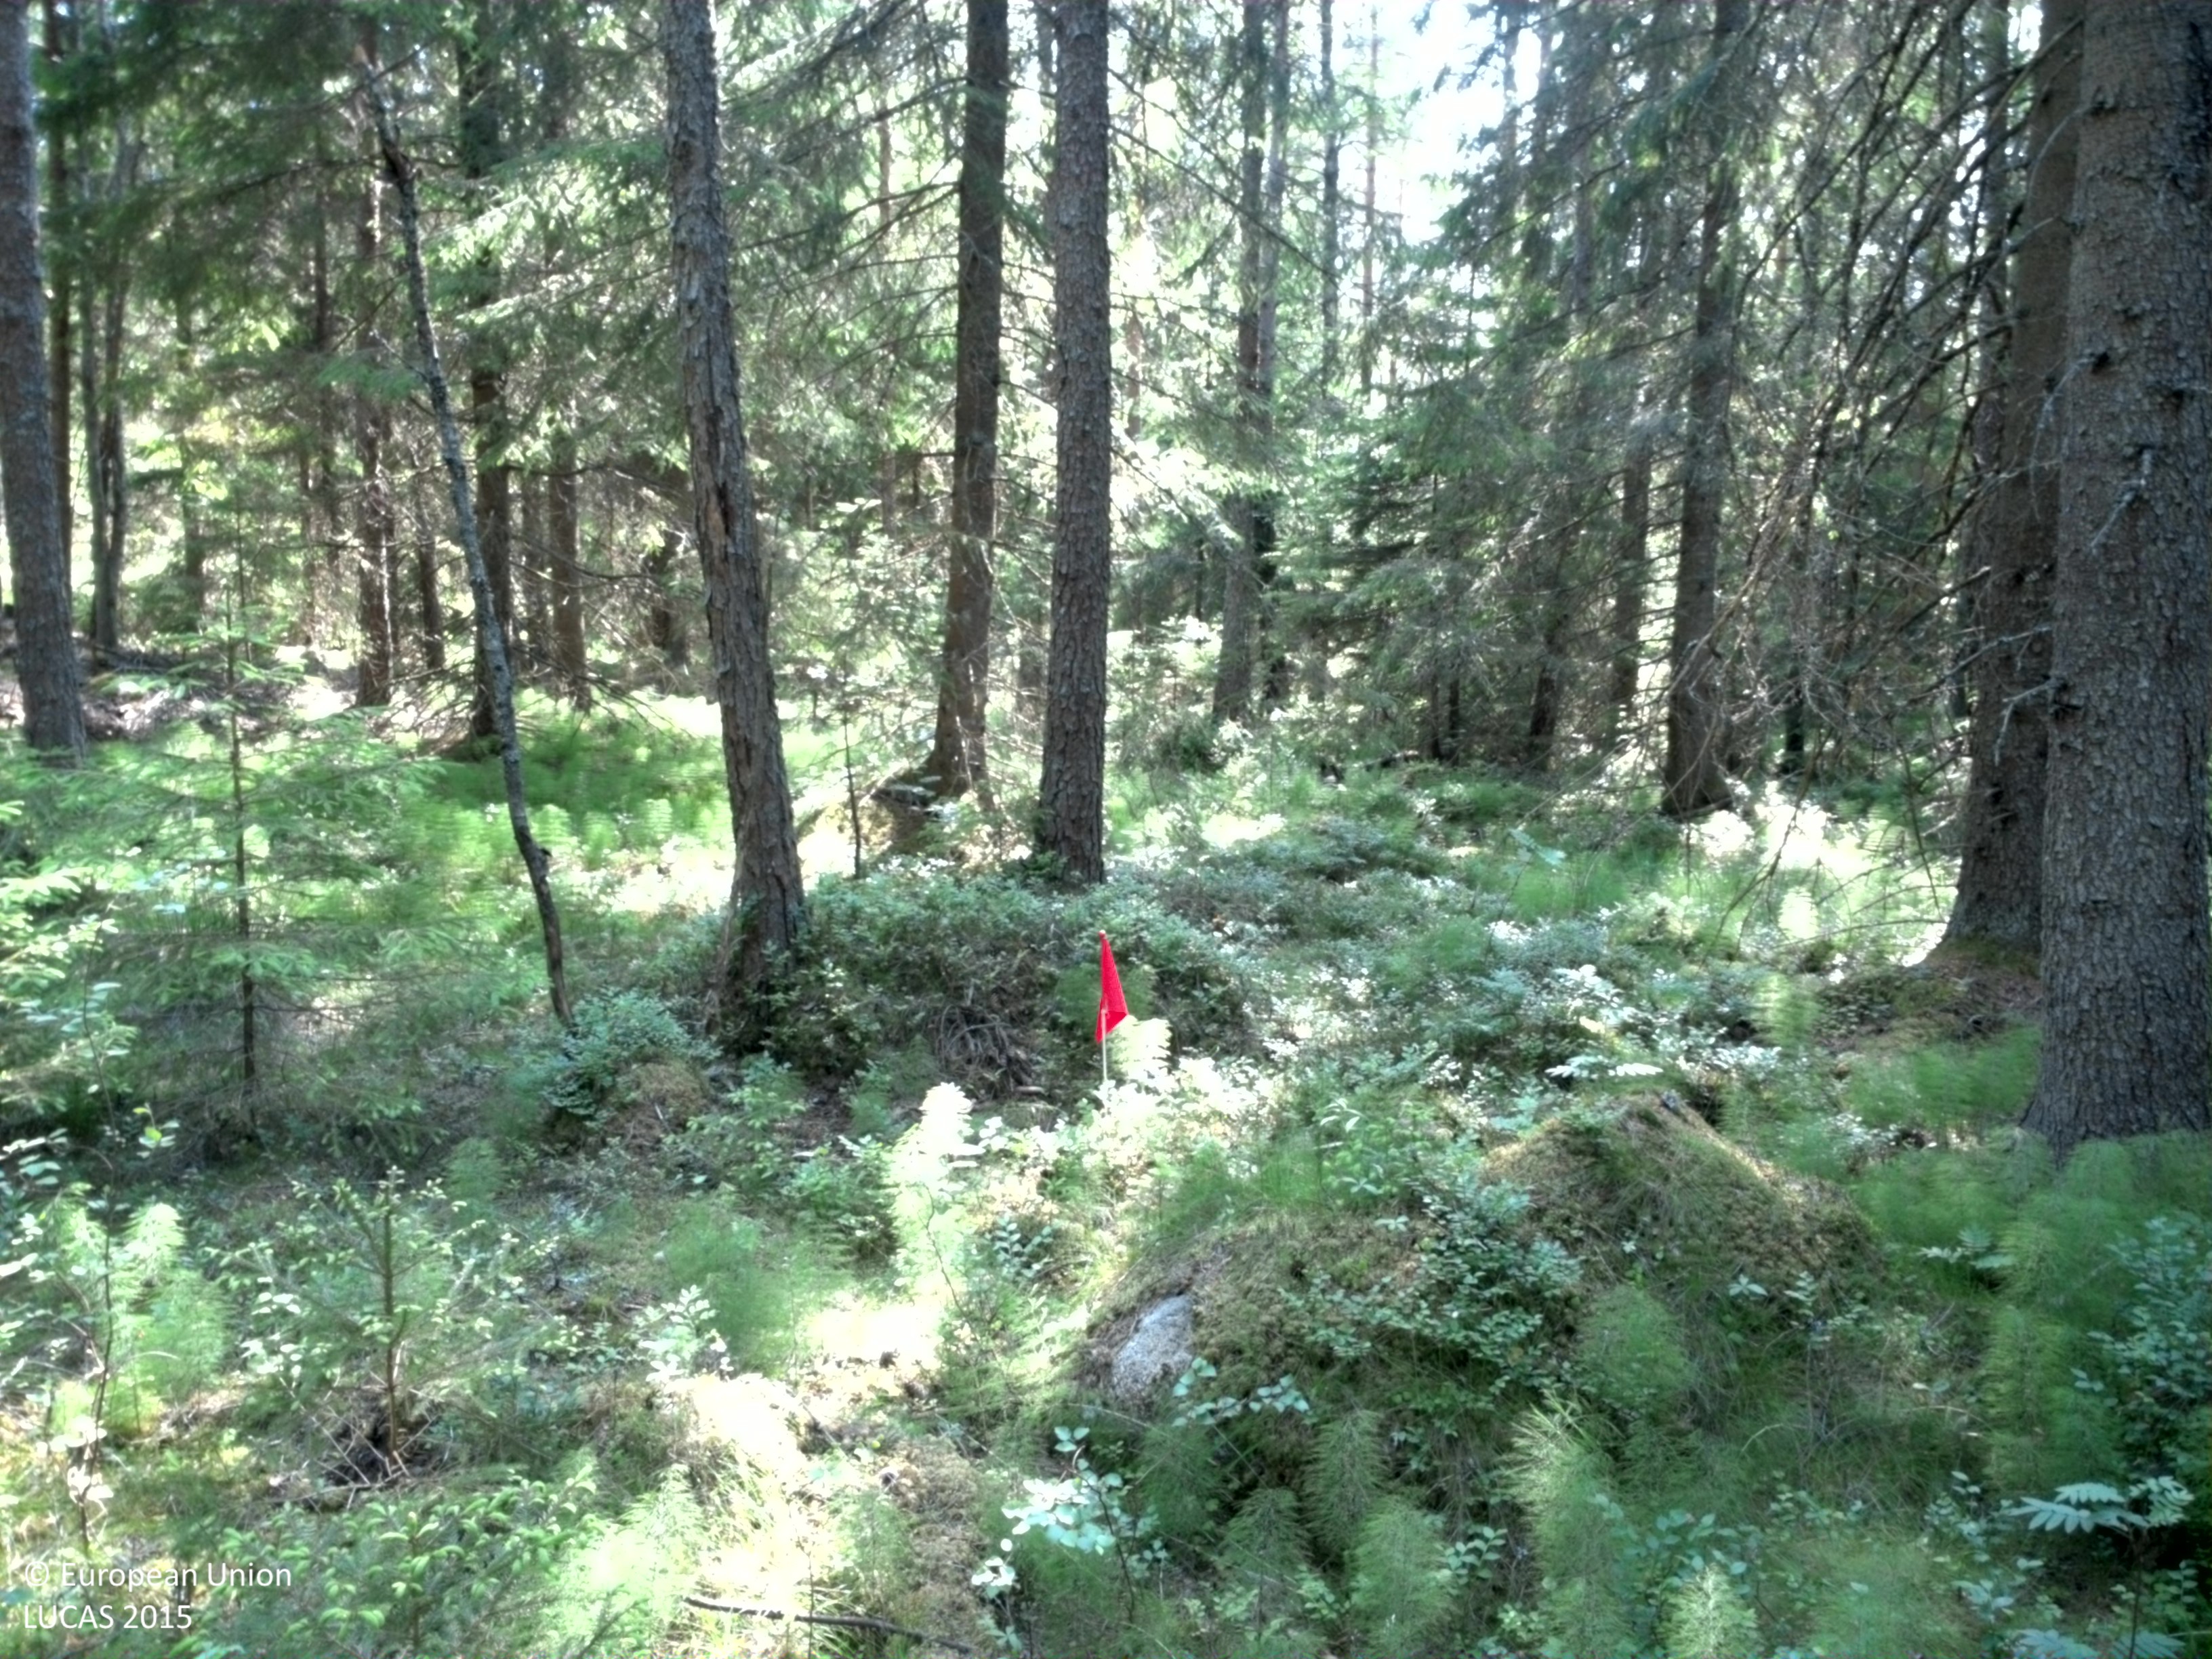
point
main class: Woodland
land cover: Spruce dominated coniferous woodland
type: boreal forest
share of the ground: 50 - 75 %
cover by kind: coniferous forest trees 70 %, shrubs 10 %, lichens and mosses 10 %, broadleaved forest trees 5 %, herbaceous plants 5 %
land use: Forestry
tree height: > 5 m
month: July
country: SE
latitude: 57.6219
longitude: 13.9299
